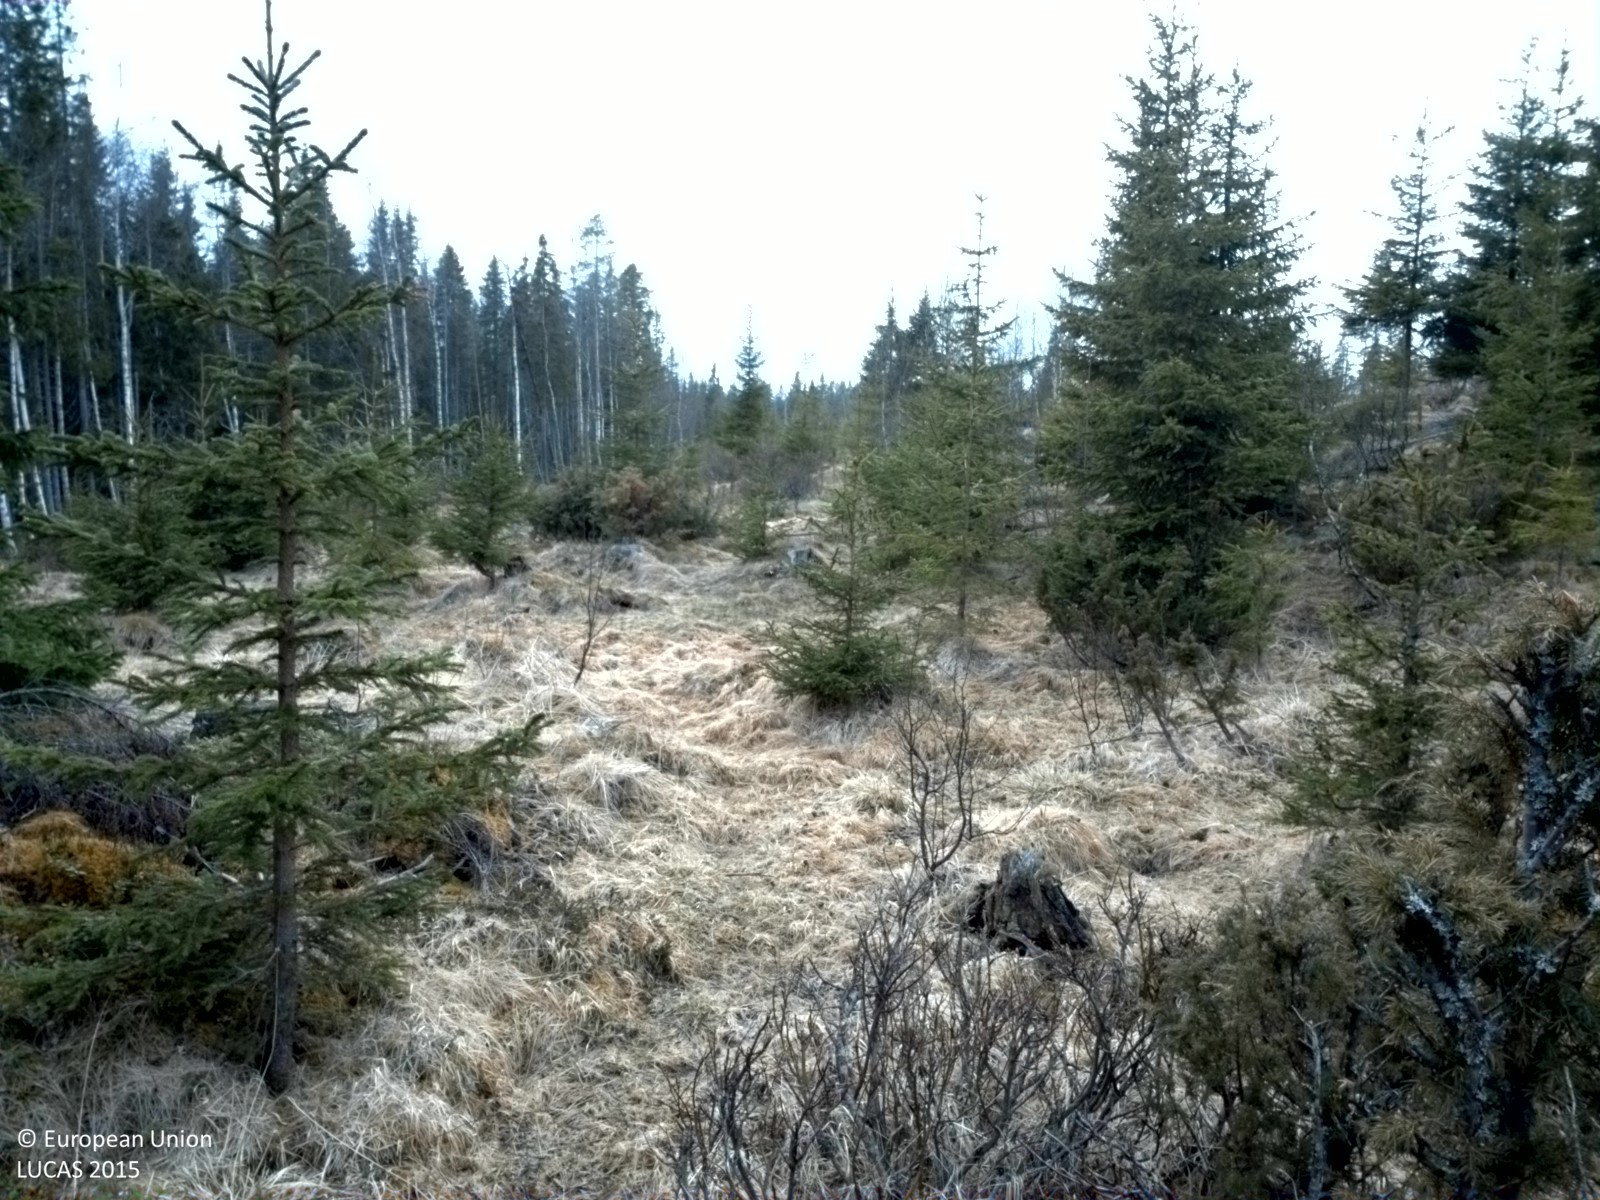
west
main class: Woodland
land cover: Spruce dominated mixed woodland
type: boreal forest
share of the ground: > 75 %
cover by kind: coniferous forest trees 50 %, shrubs 30 %, broadleaved forest trees 20 %
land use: Forestry
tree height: < 5 m
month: May
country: SE
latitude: 63.4118
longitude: 13.8456
